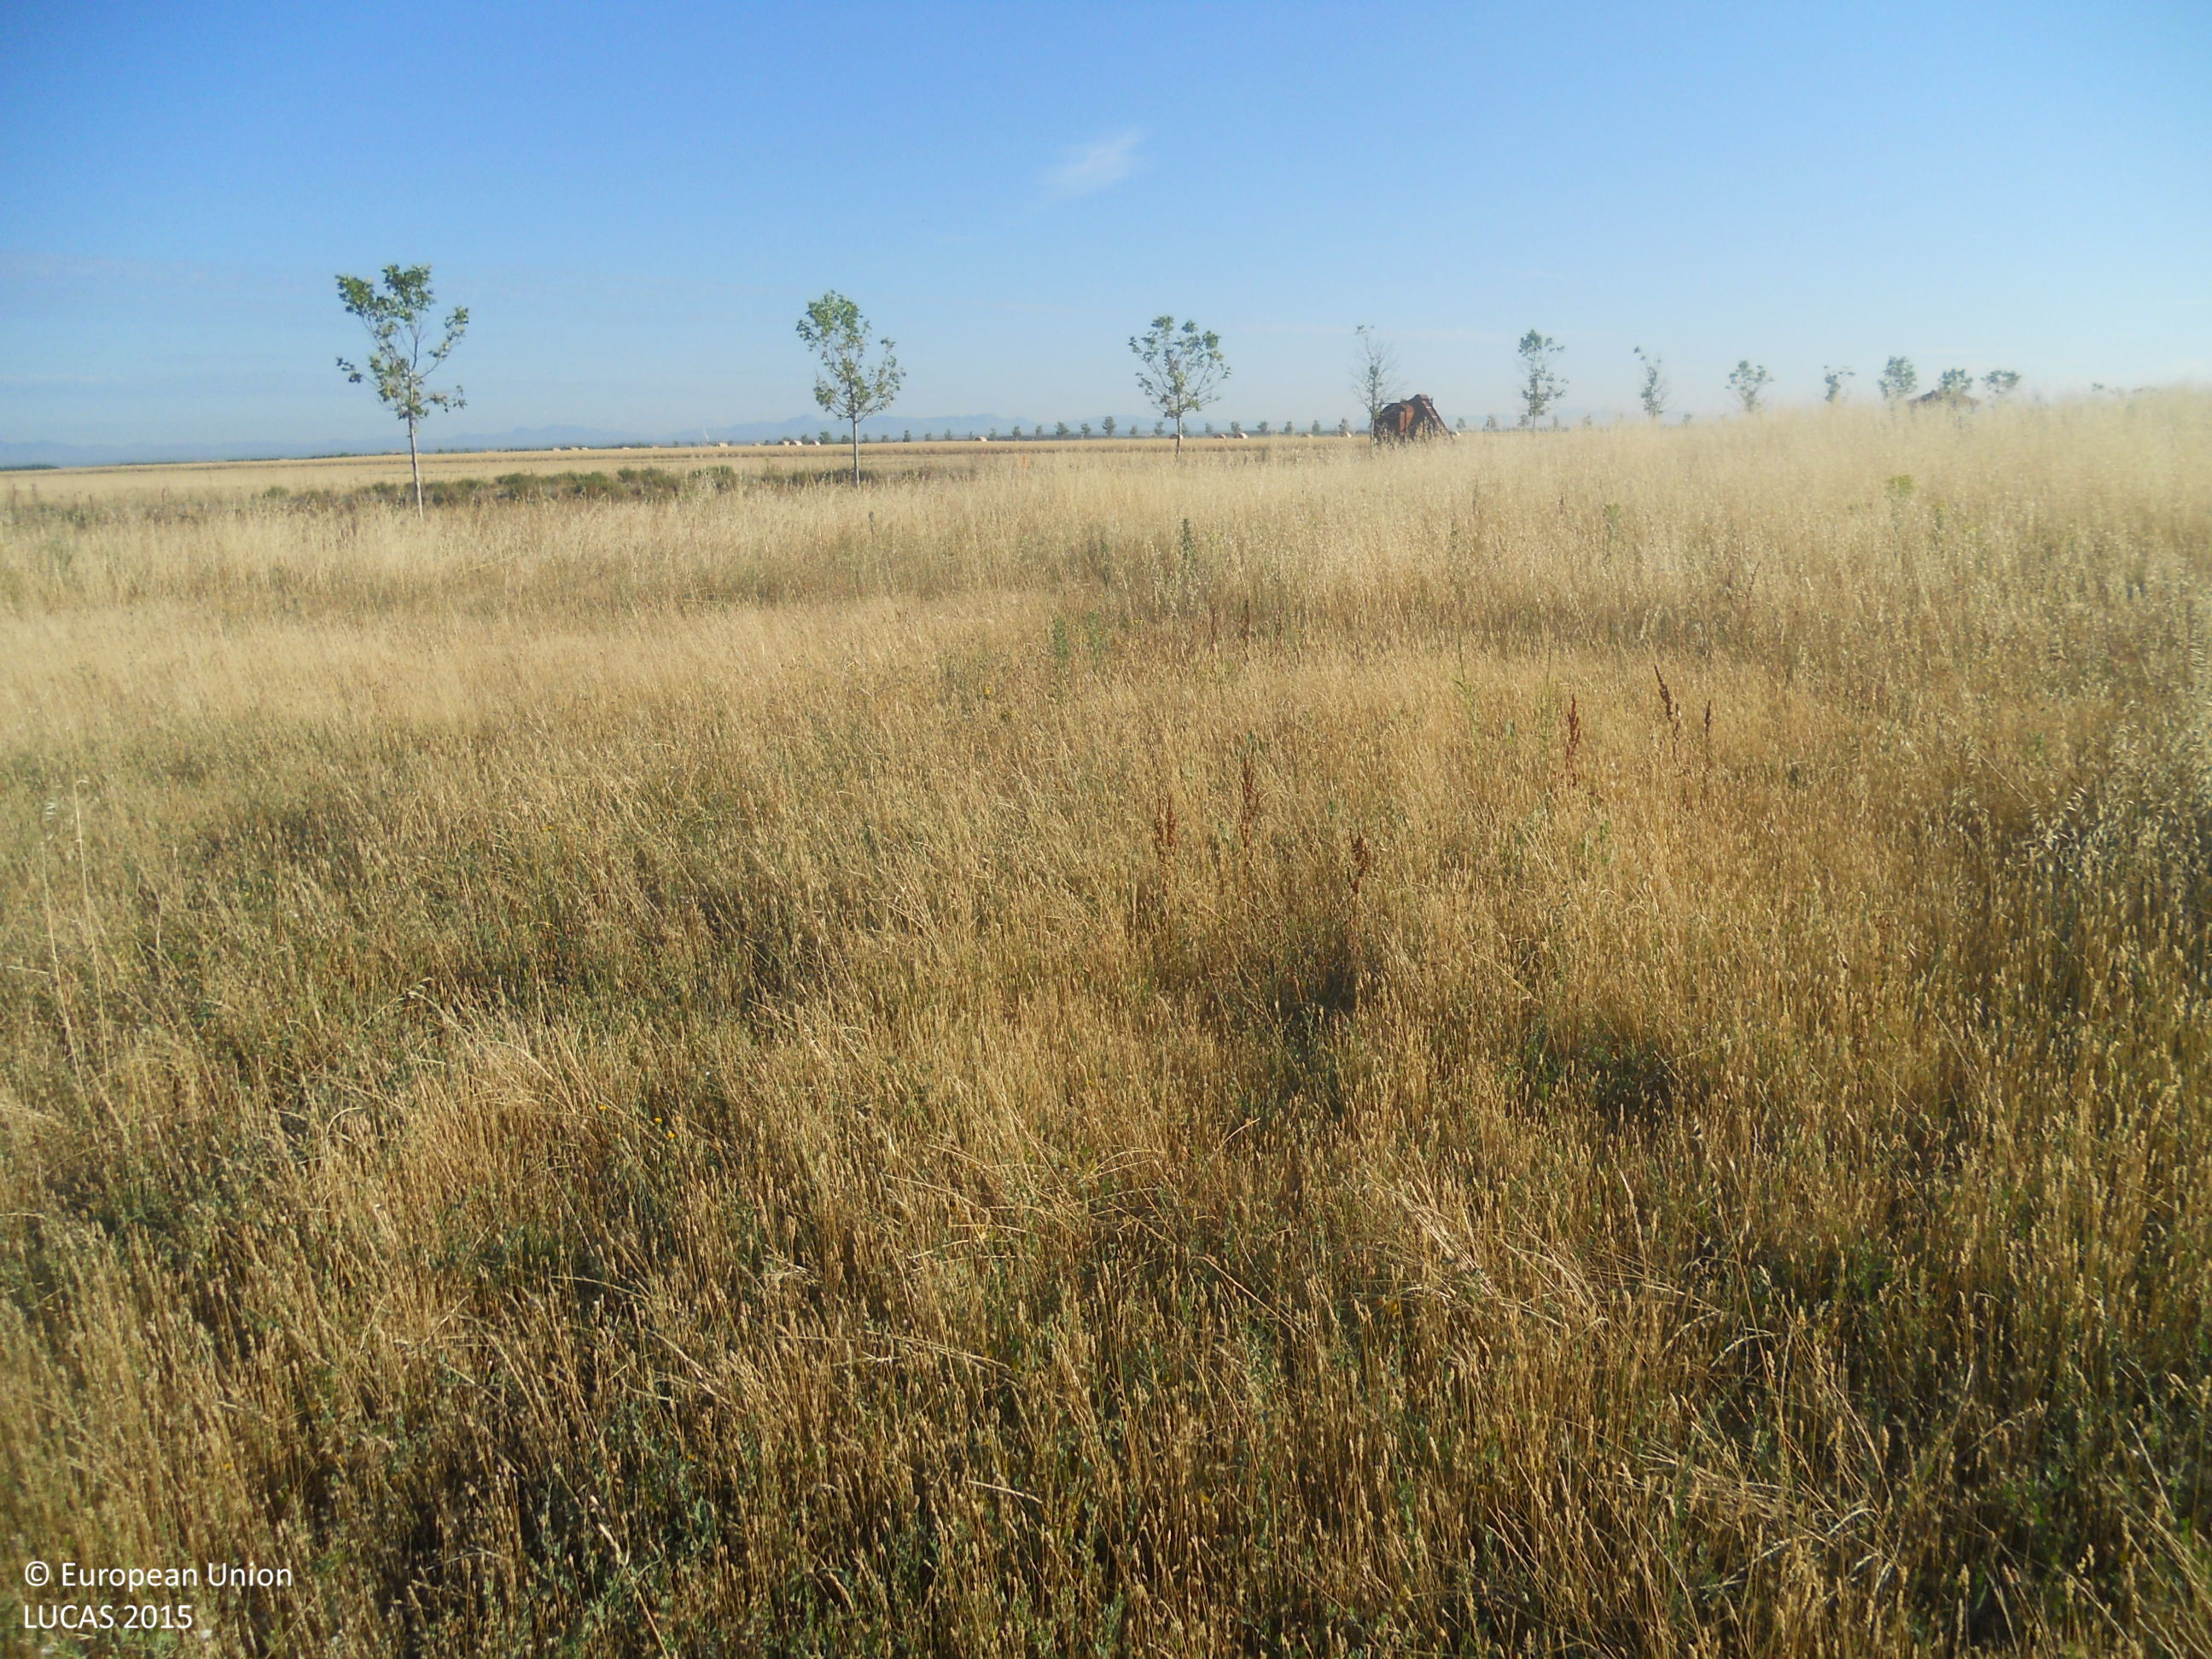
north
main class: Grassland
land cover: Grassland without tree/shrub cover
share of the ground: > 75 %
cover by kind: herbaceous plants 100 %
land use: Abandoned areas
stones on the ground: > 50 %
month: July
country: ES
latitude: 42.4557
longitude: -5.3020
